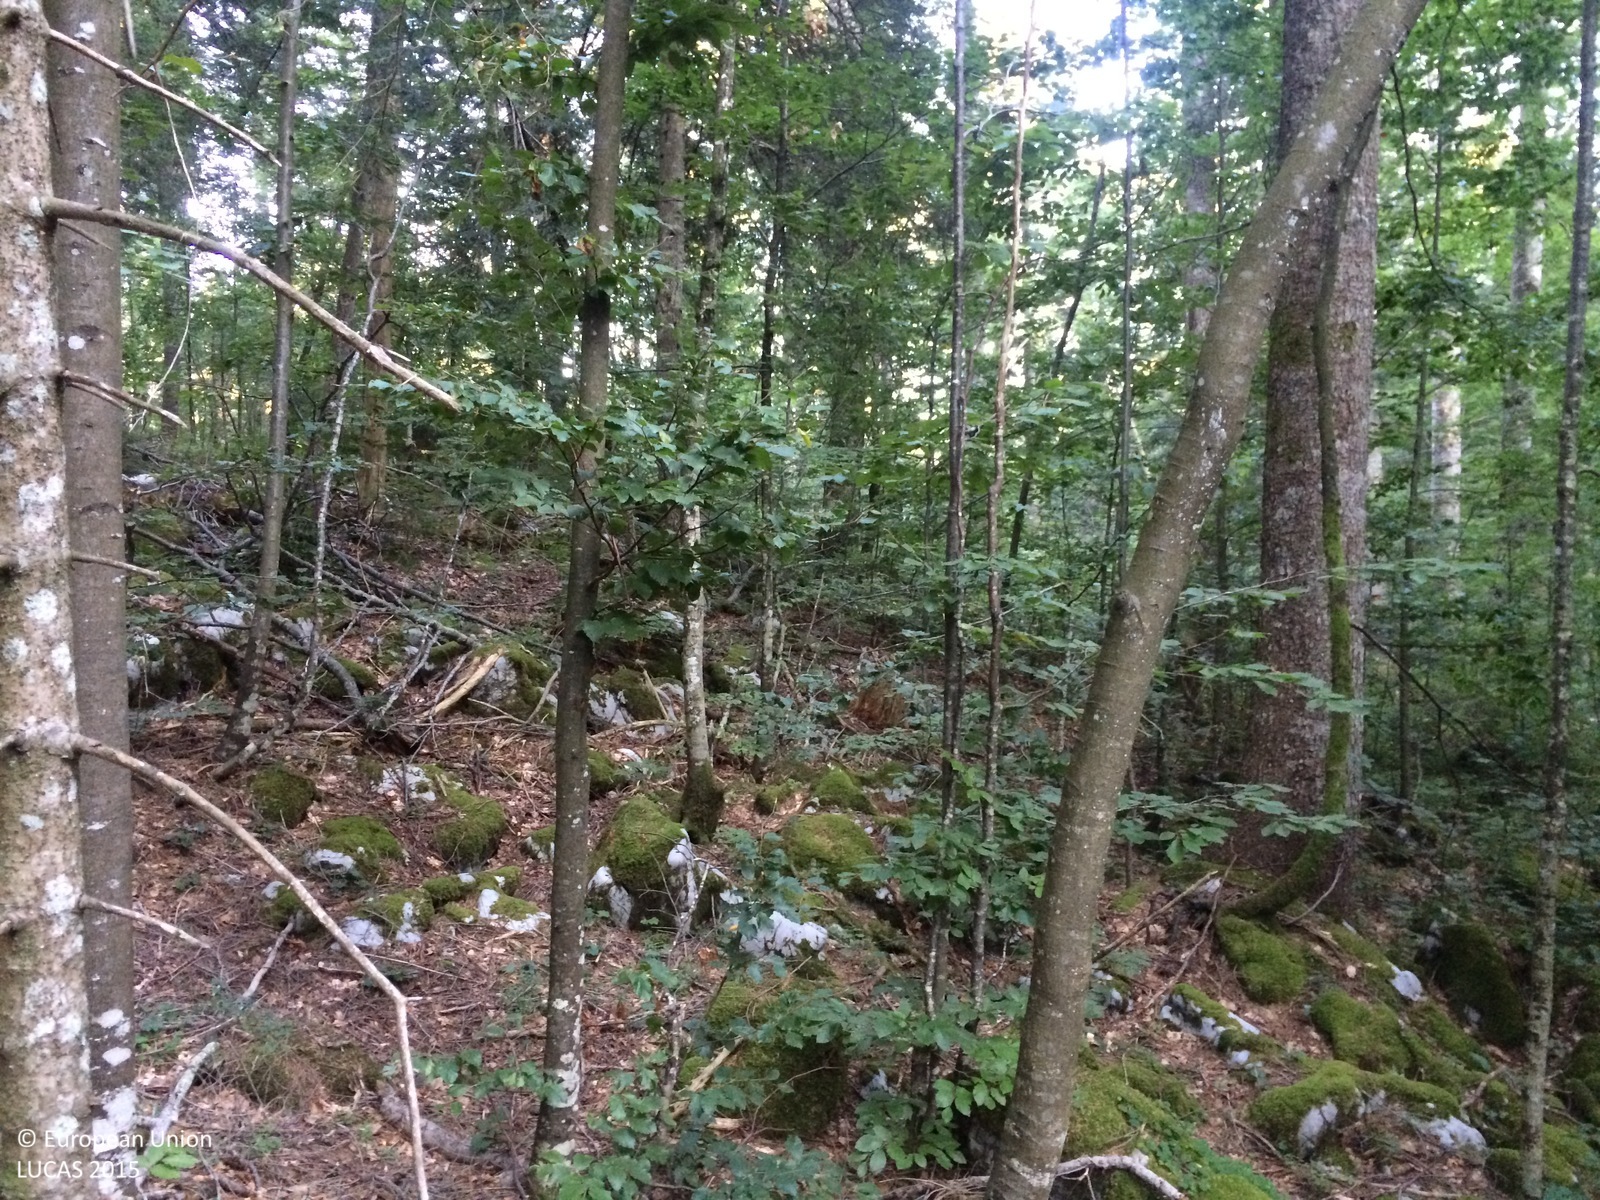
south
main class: Woodland
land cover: Other mixed woodland
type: mountainous beech forest
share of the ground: > 75 %
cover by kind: broadleaved forest trees 75 %, coniferous forest trees 25 %
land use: Forestry
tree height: > 5 m
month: September
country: HR
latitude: 45.5668
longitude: 14.5953
